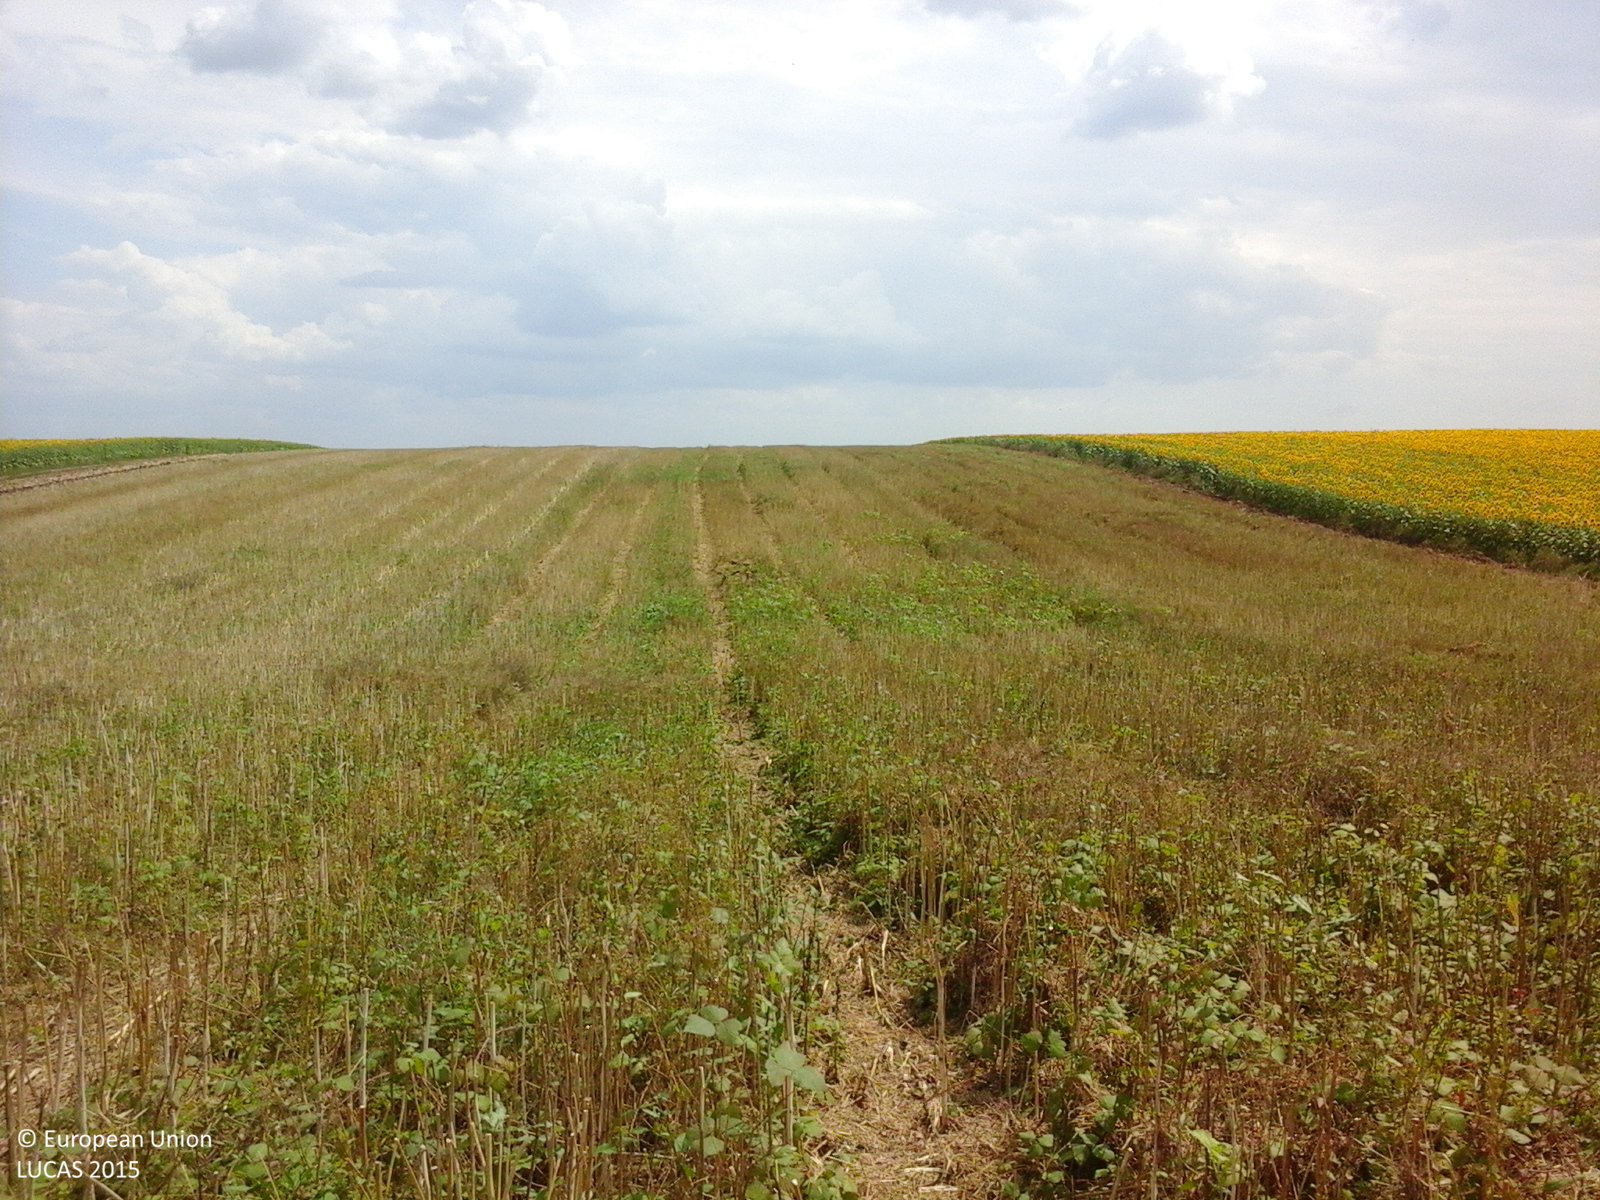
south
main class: Cropland
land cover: Rape and turnip rape
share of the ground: < 10 %
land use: Agriculture (excluding fallow land and kitchen gardens)
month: June
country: RO
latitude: 44.1186
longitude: 26.2884
